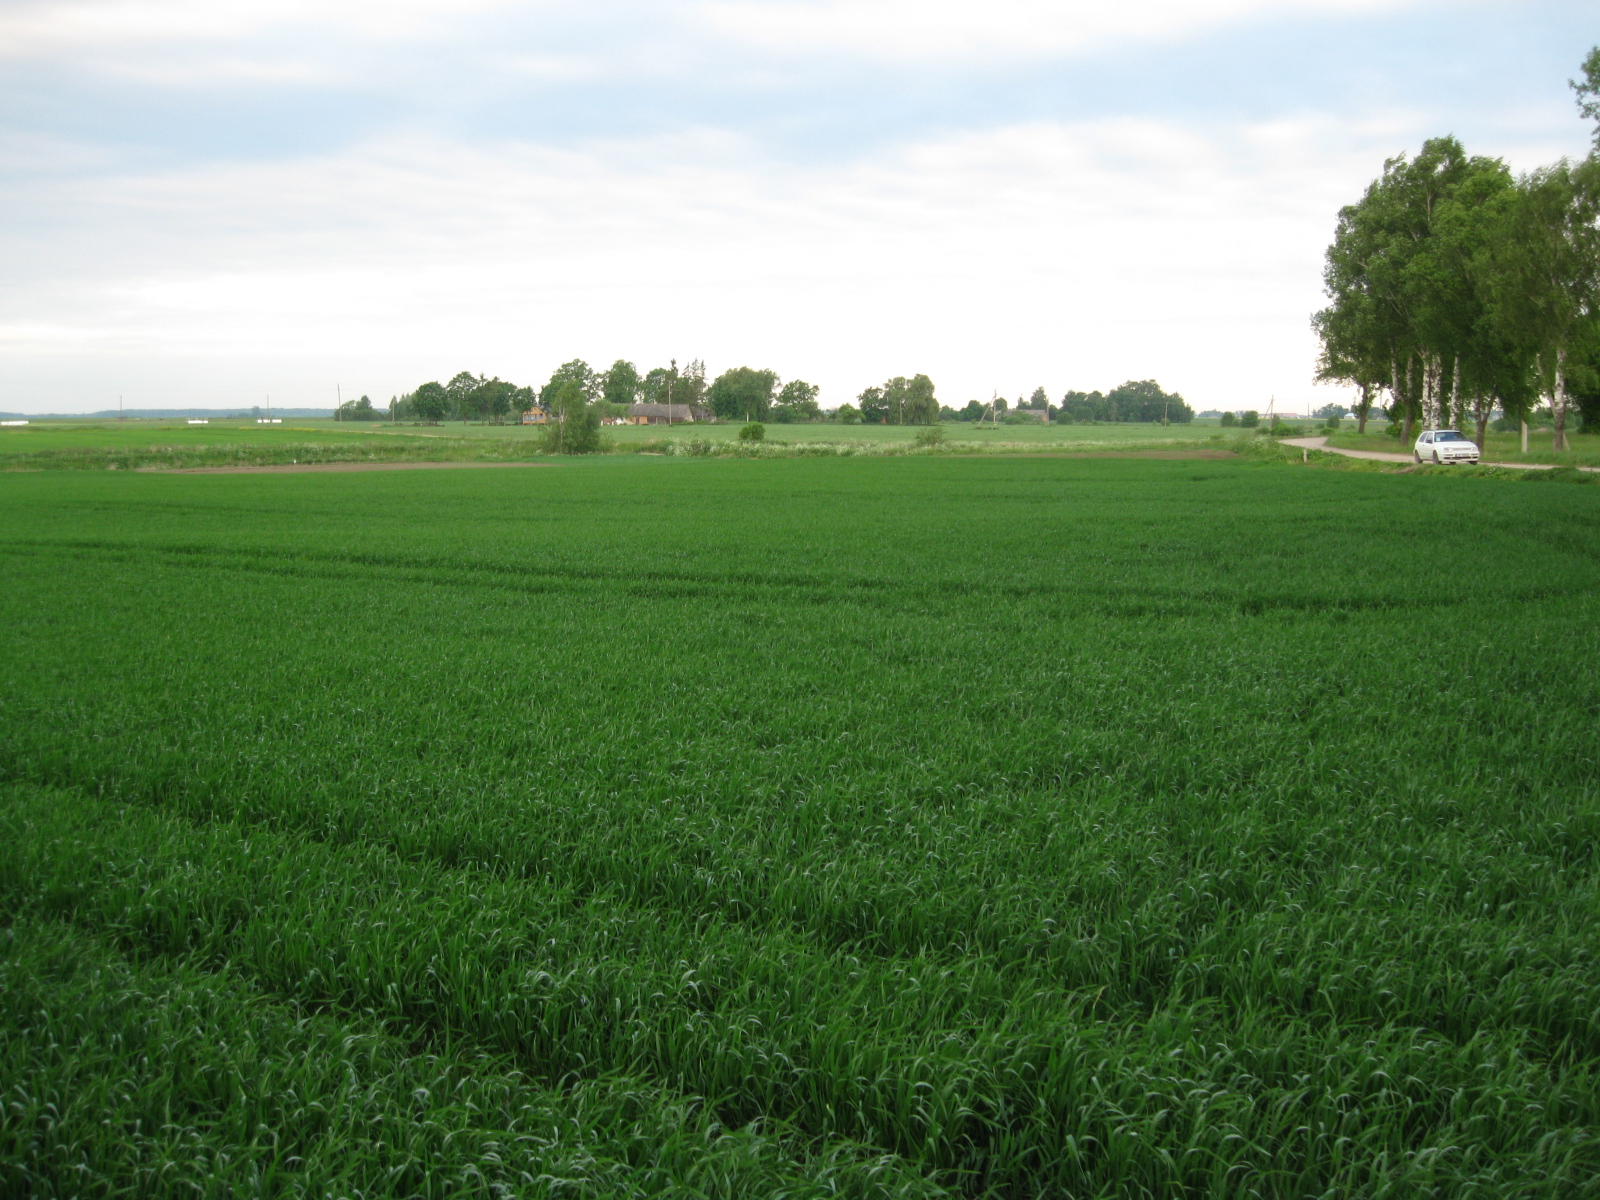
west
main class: Cropland
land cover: Common wheat
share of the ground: > 75 %
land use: Agriculture (excluding fallow land and kitchen gardens)
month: June
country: LT
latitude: 55.7236
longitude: 24.0197
